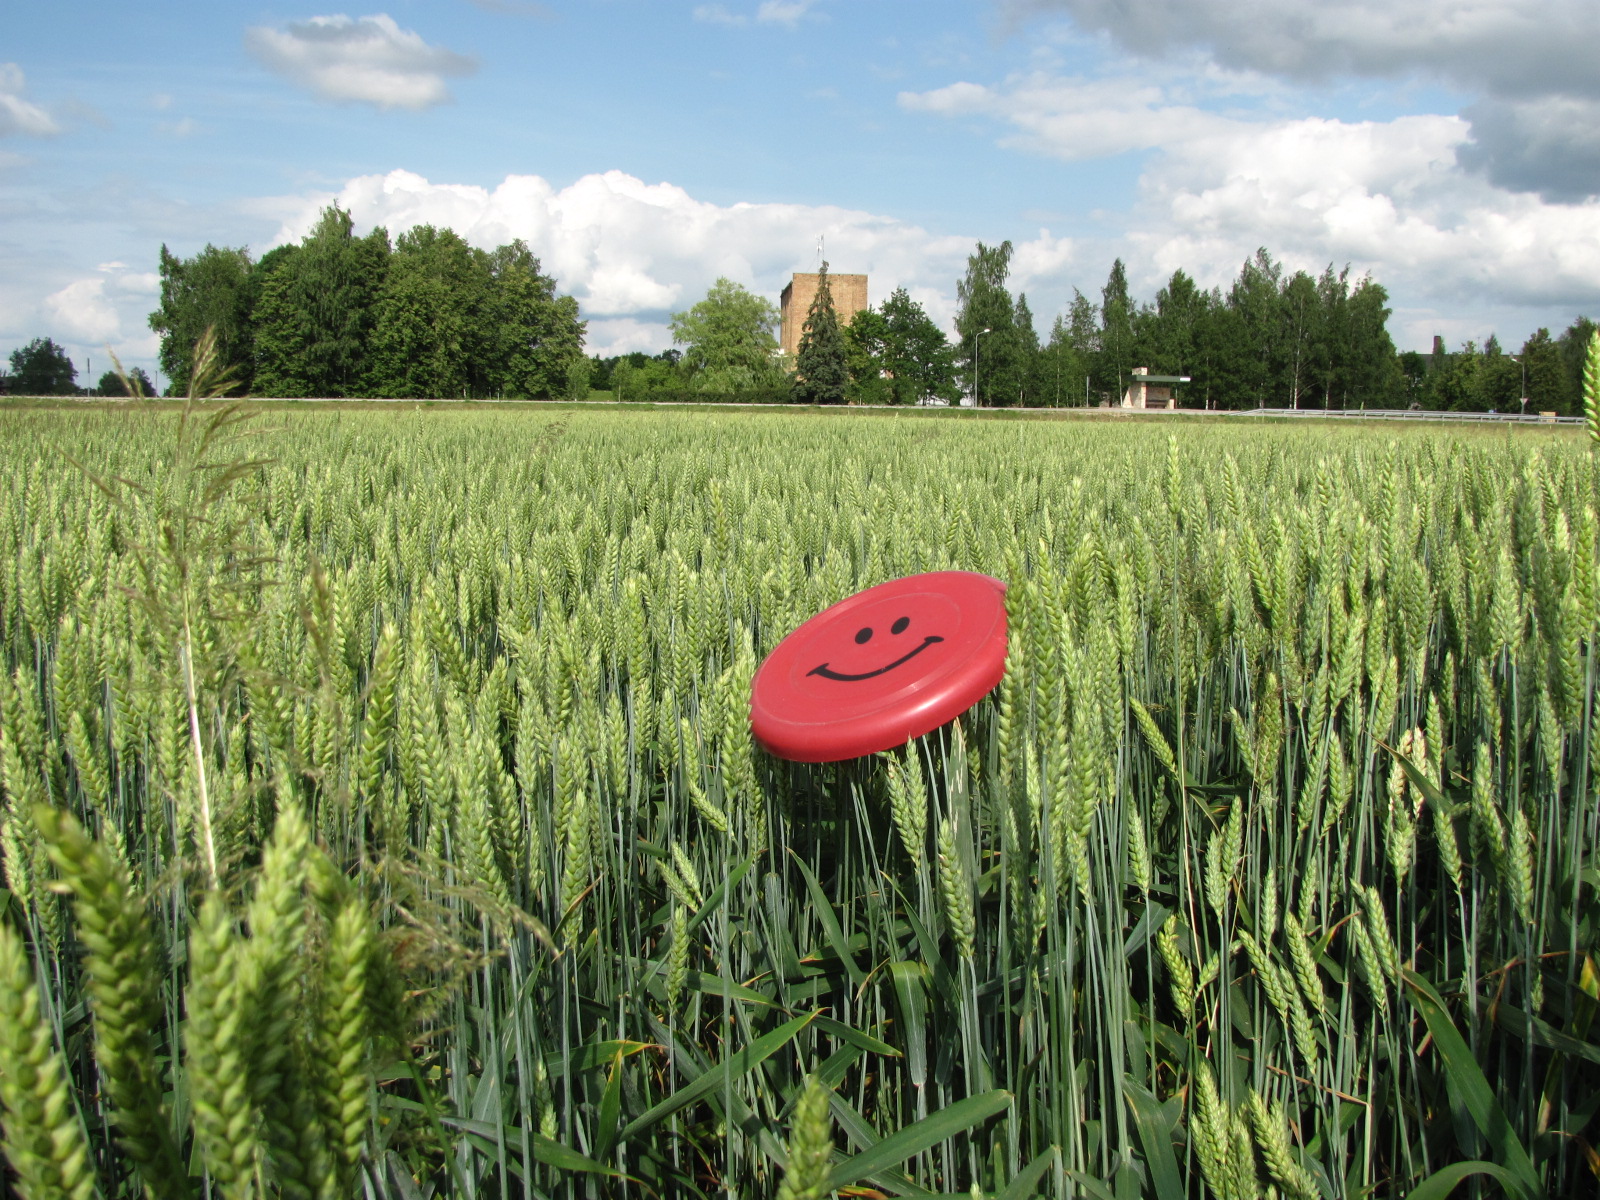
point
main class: Cropland
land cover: Common wheat
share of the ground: > 75 %
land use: Agriculture (excluding fallow land and kitchen gardens)
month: July
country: LV
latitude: 56.3103
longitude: 24.3342
